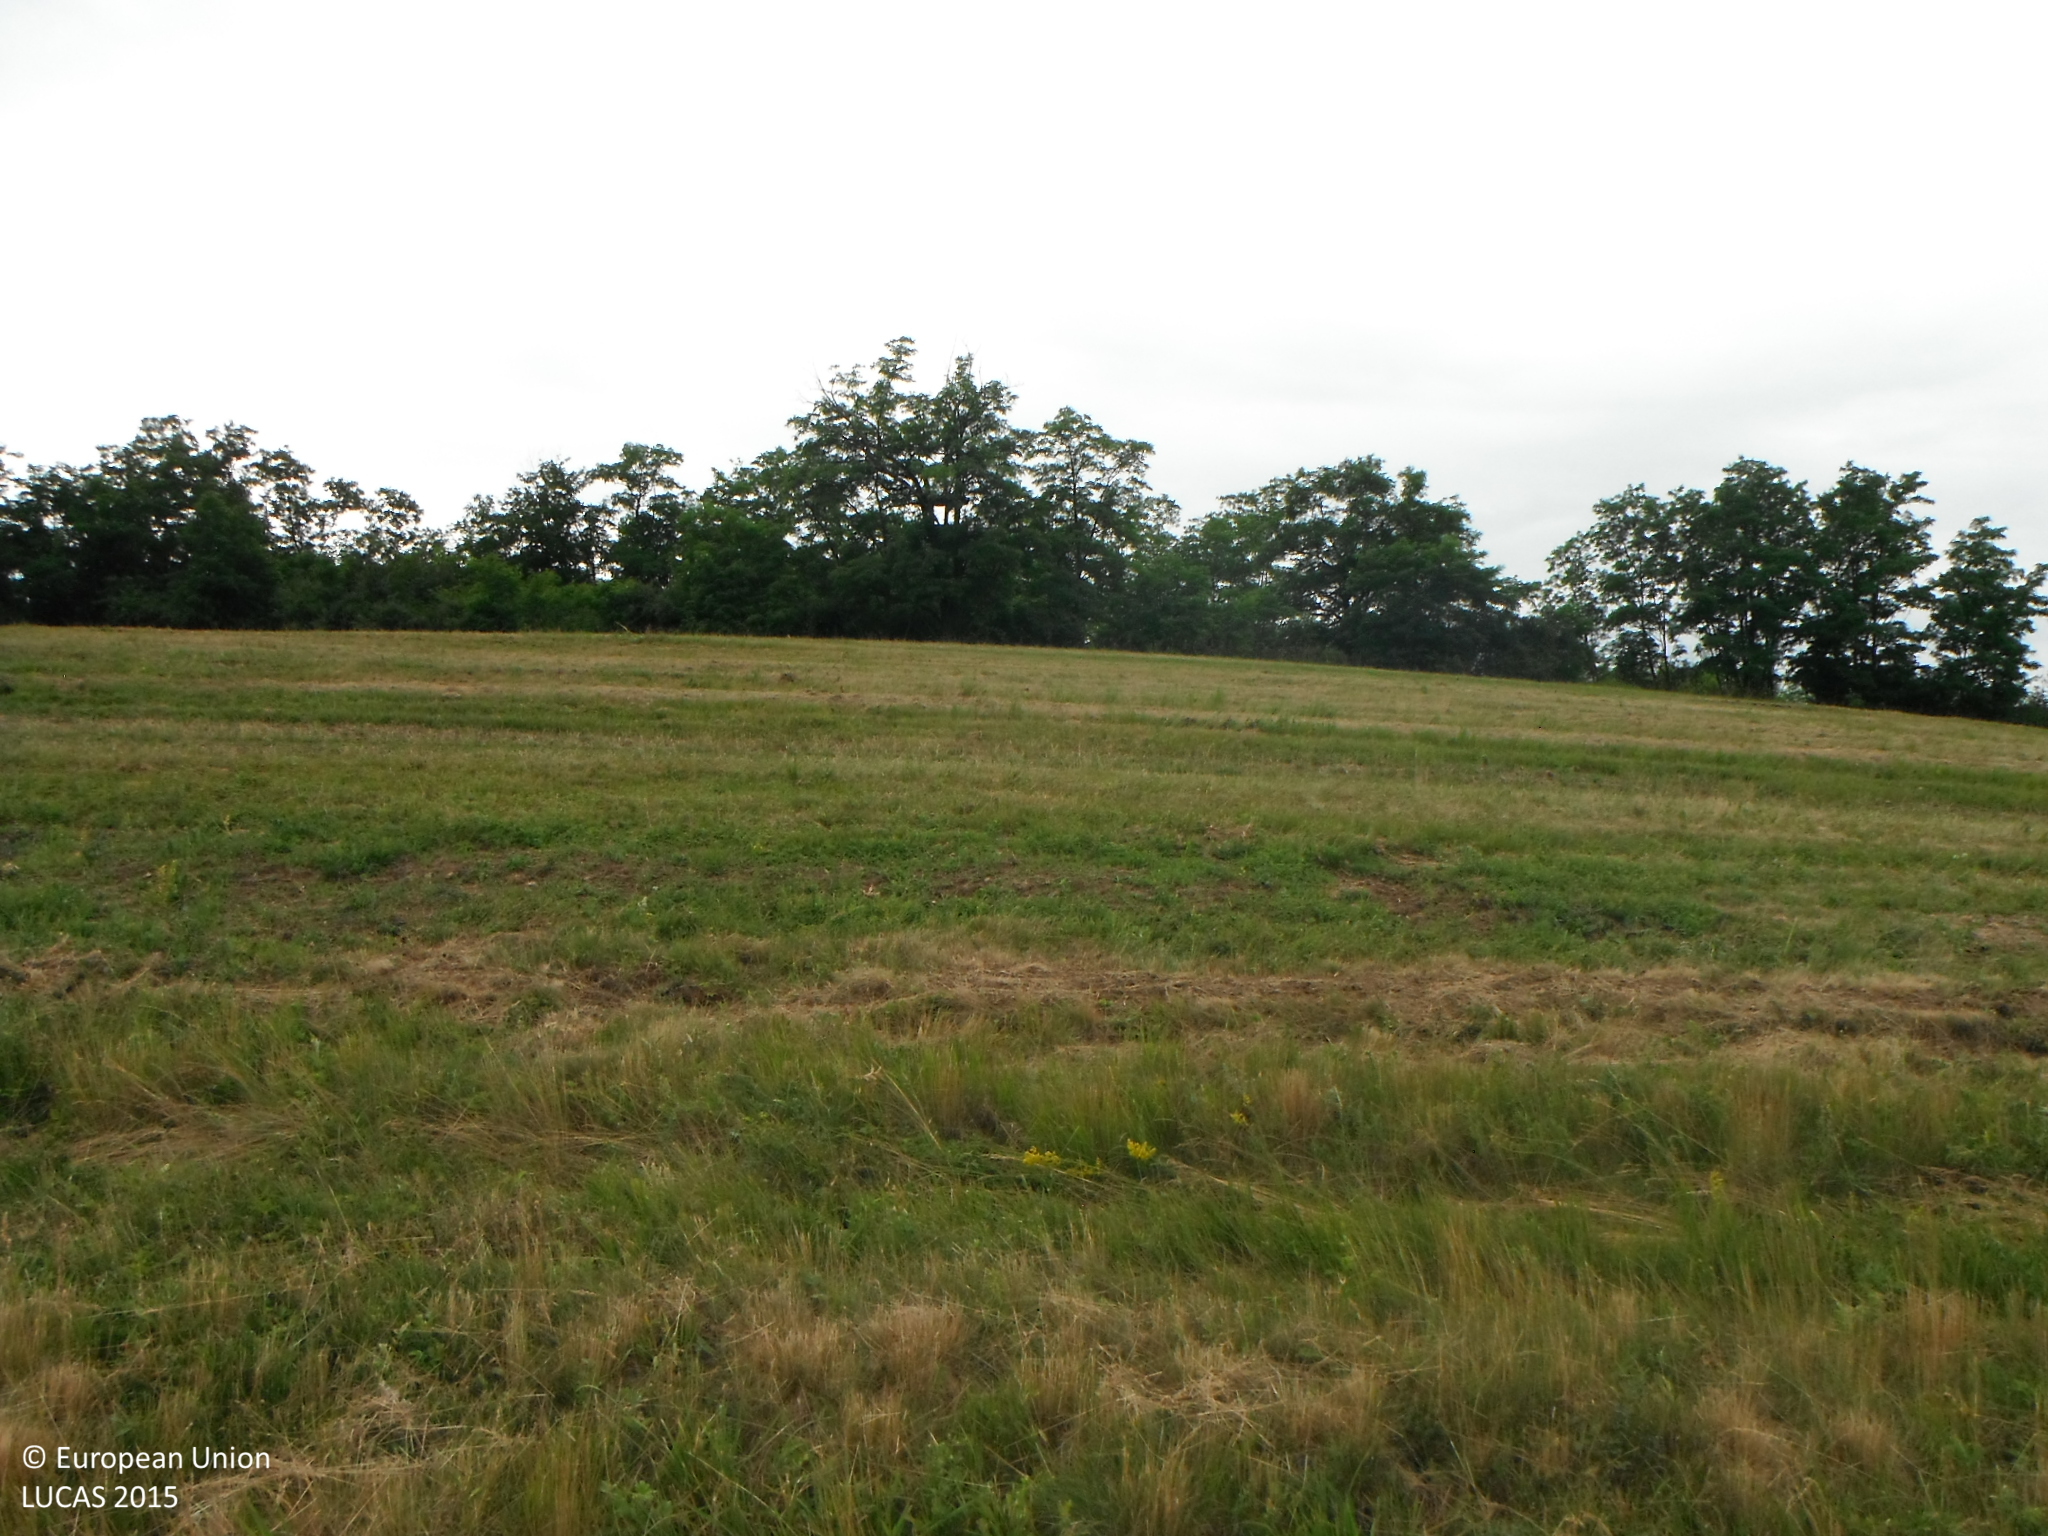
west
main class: Grassland
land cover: Grassland without tree/shrub cover
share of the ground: > 75 %
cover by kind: herbaceous plants 100 %
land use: Agriculture (excluding fallow land and kitchen gardens)
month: June
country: SK
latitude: 48.1701
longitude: 18.9073
